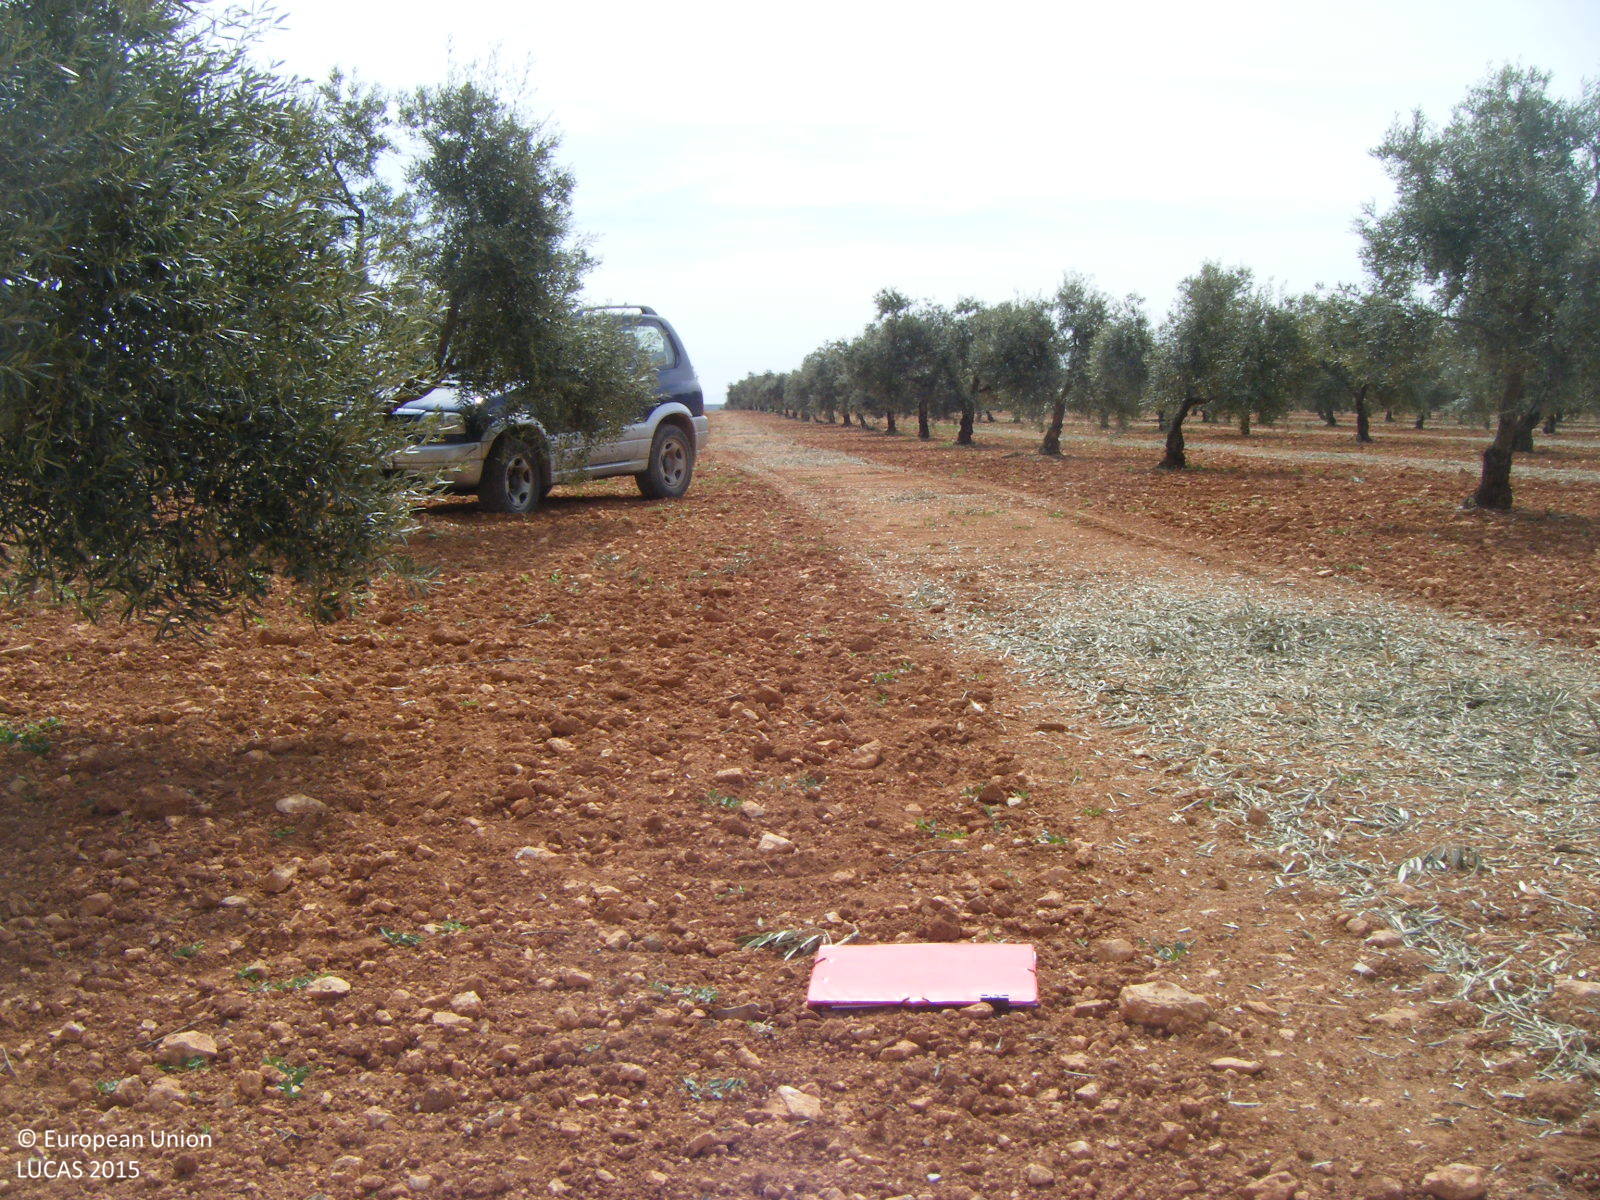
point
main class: Cropland
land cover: Olive groves
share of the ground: 10 - 25 %
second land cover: Other bare soil
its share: > 75 %
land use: Agriculture (excluding fallow land and kitchen gardens)
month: April
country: ES
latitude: 37.1052
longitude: -4.7527
